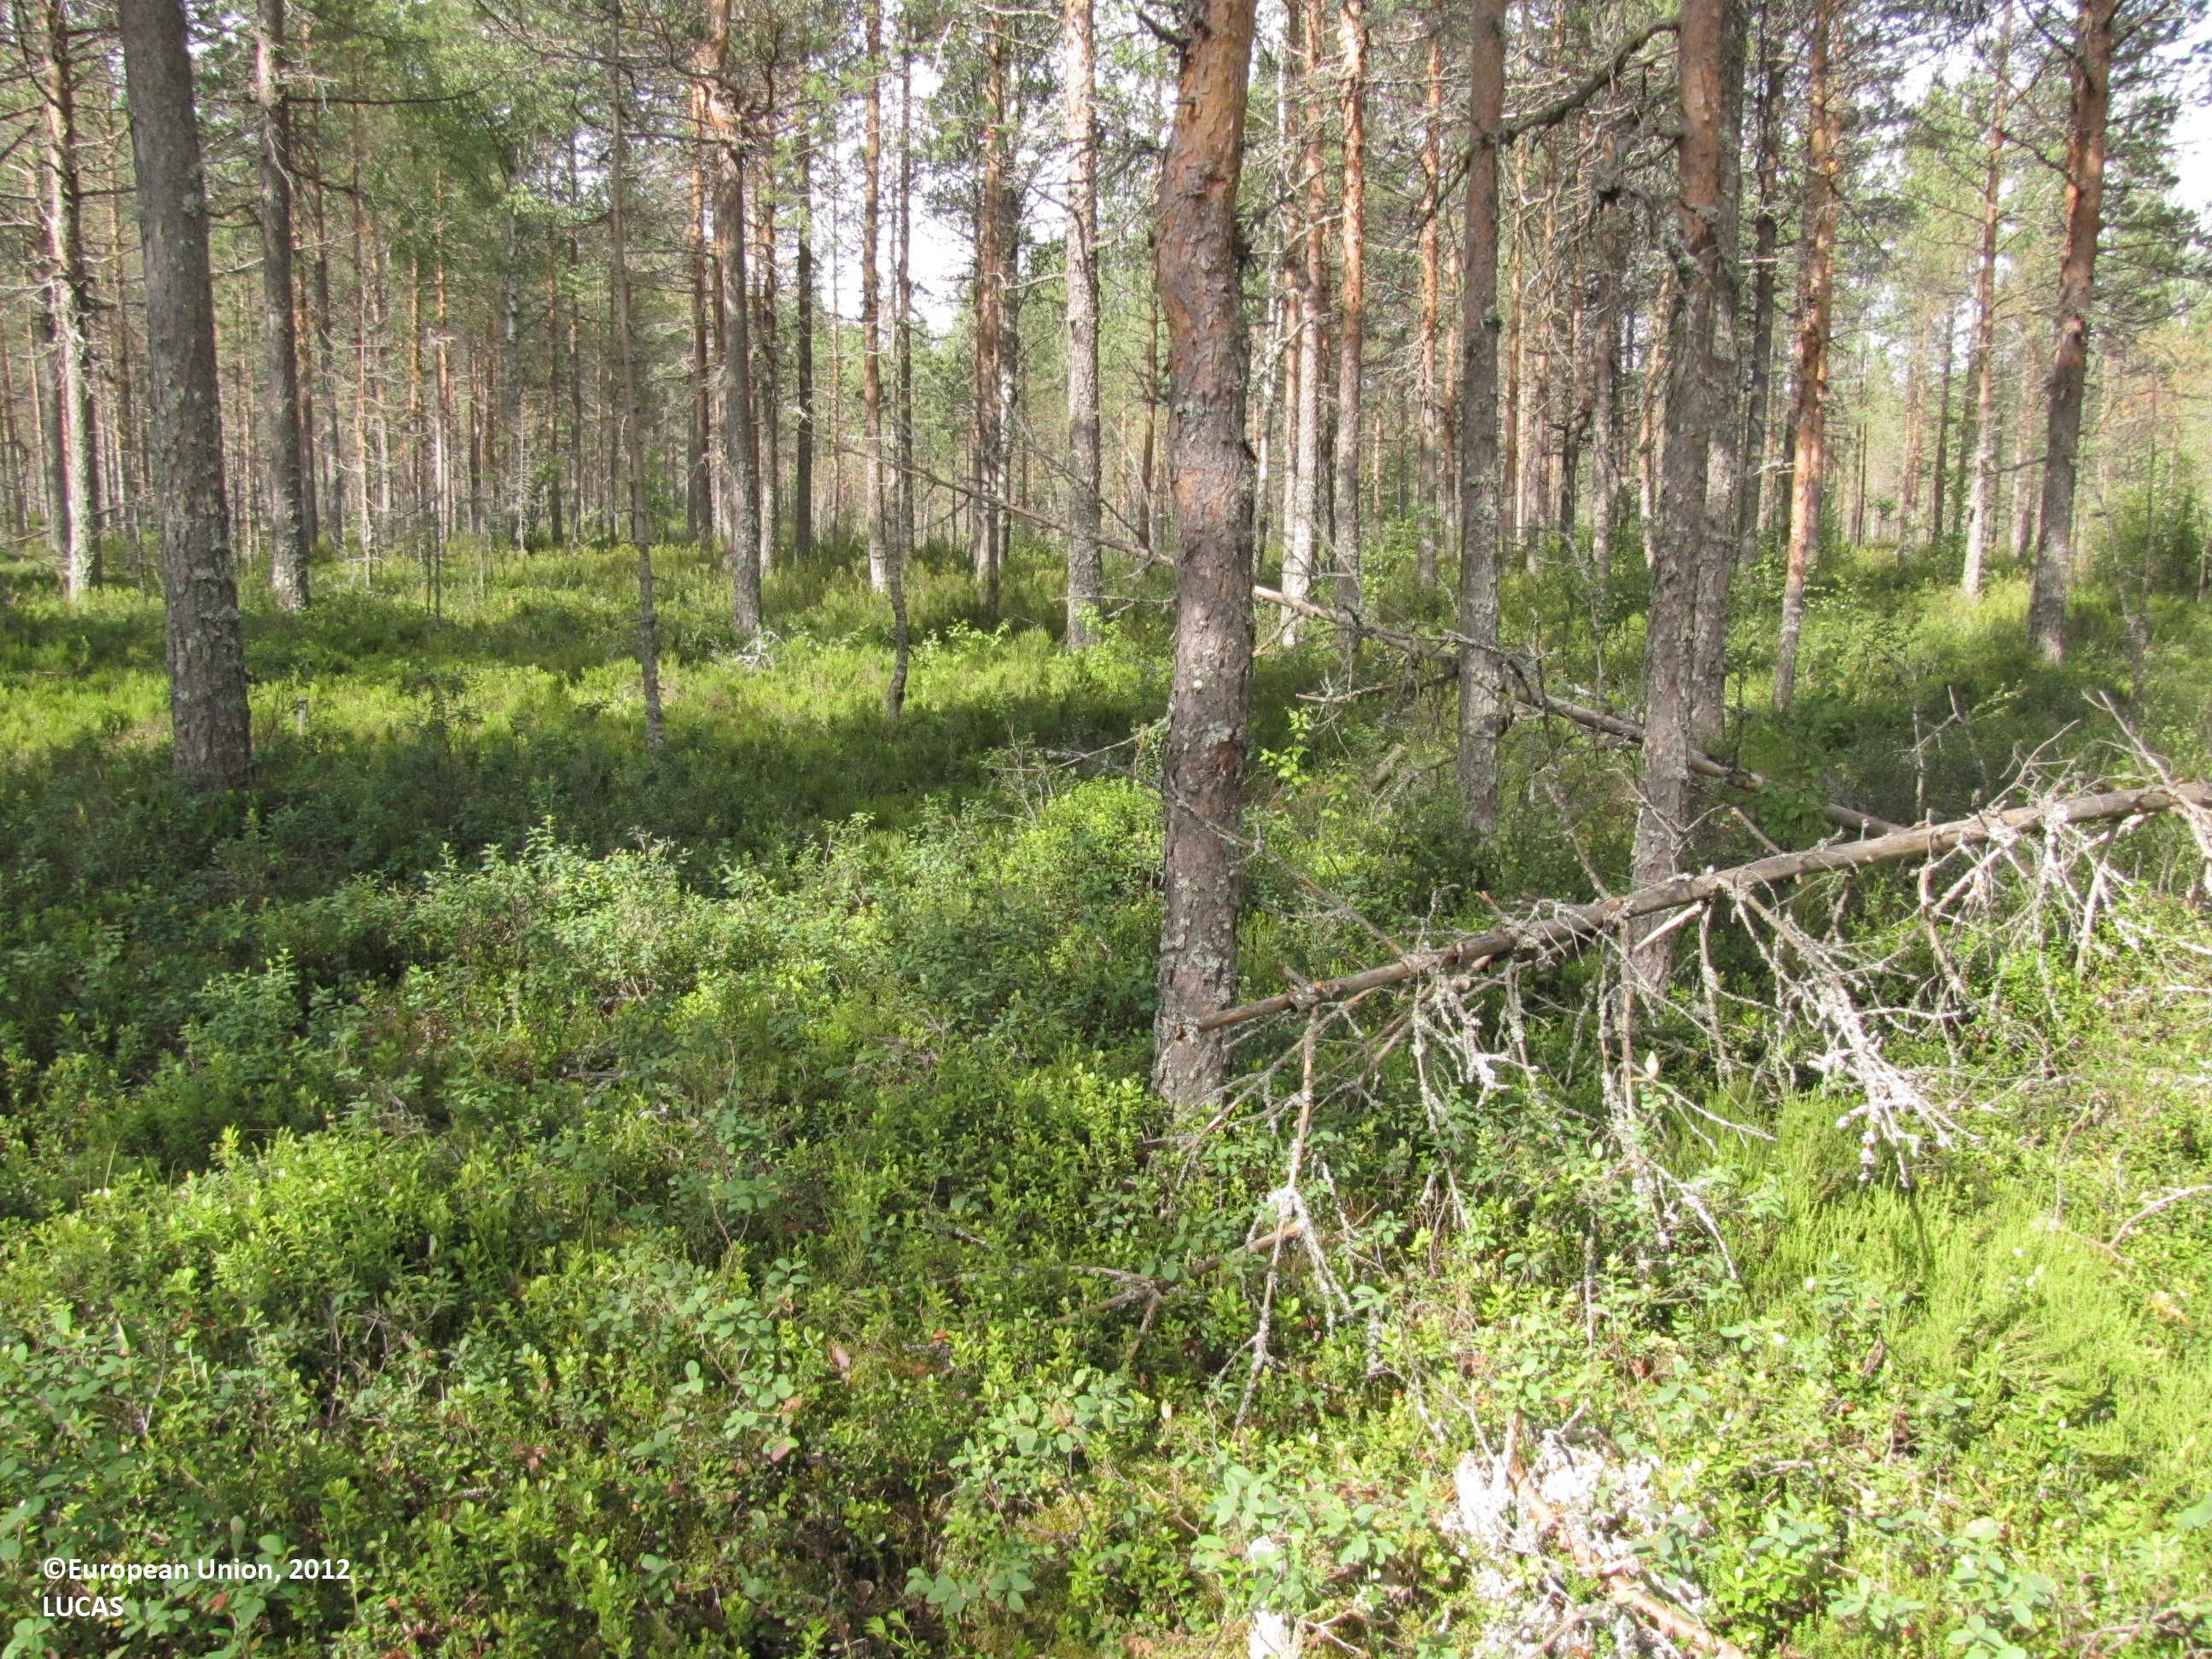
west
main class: Woodland
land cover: Pine dominated coniferous woodland
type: mire and swamp forests
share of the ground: 50 - 75 %
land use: Forestry
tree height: > 5 m
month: July
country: FI
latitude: 62.3978
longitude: 23.1639
